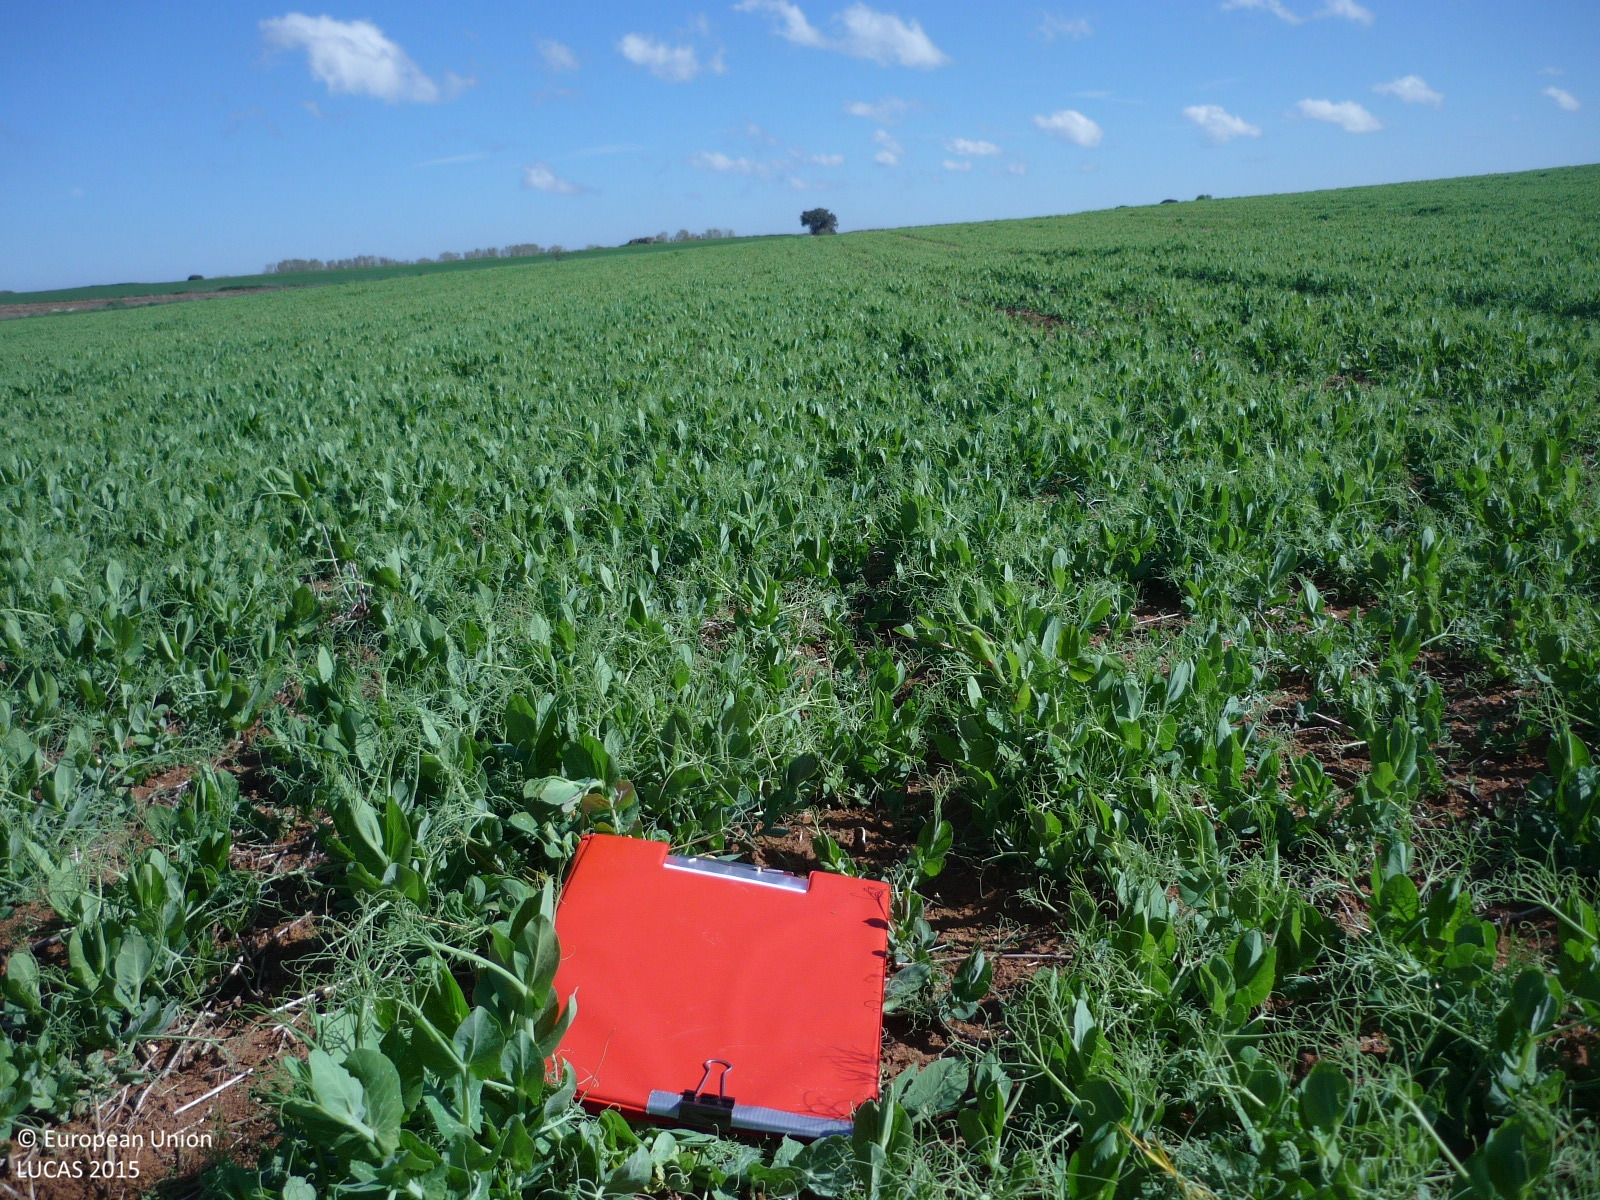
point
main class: Cropland
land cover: Dry pulses
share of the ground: > 75 %
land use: Agriculture (excluding fallow land and kitchen gardens)
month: April
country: ES
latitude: 40.4444
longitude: -3.2487
